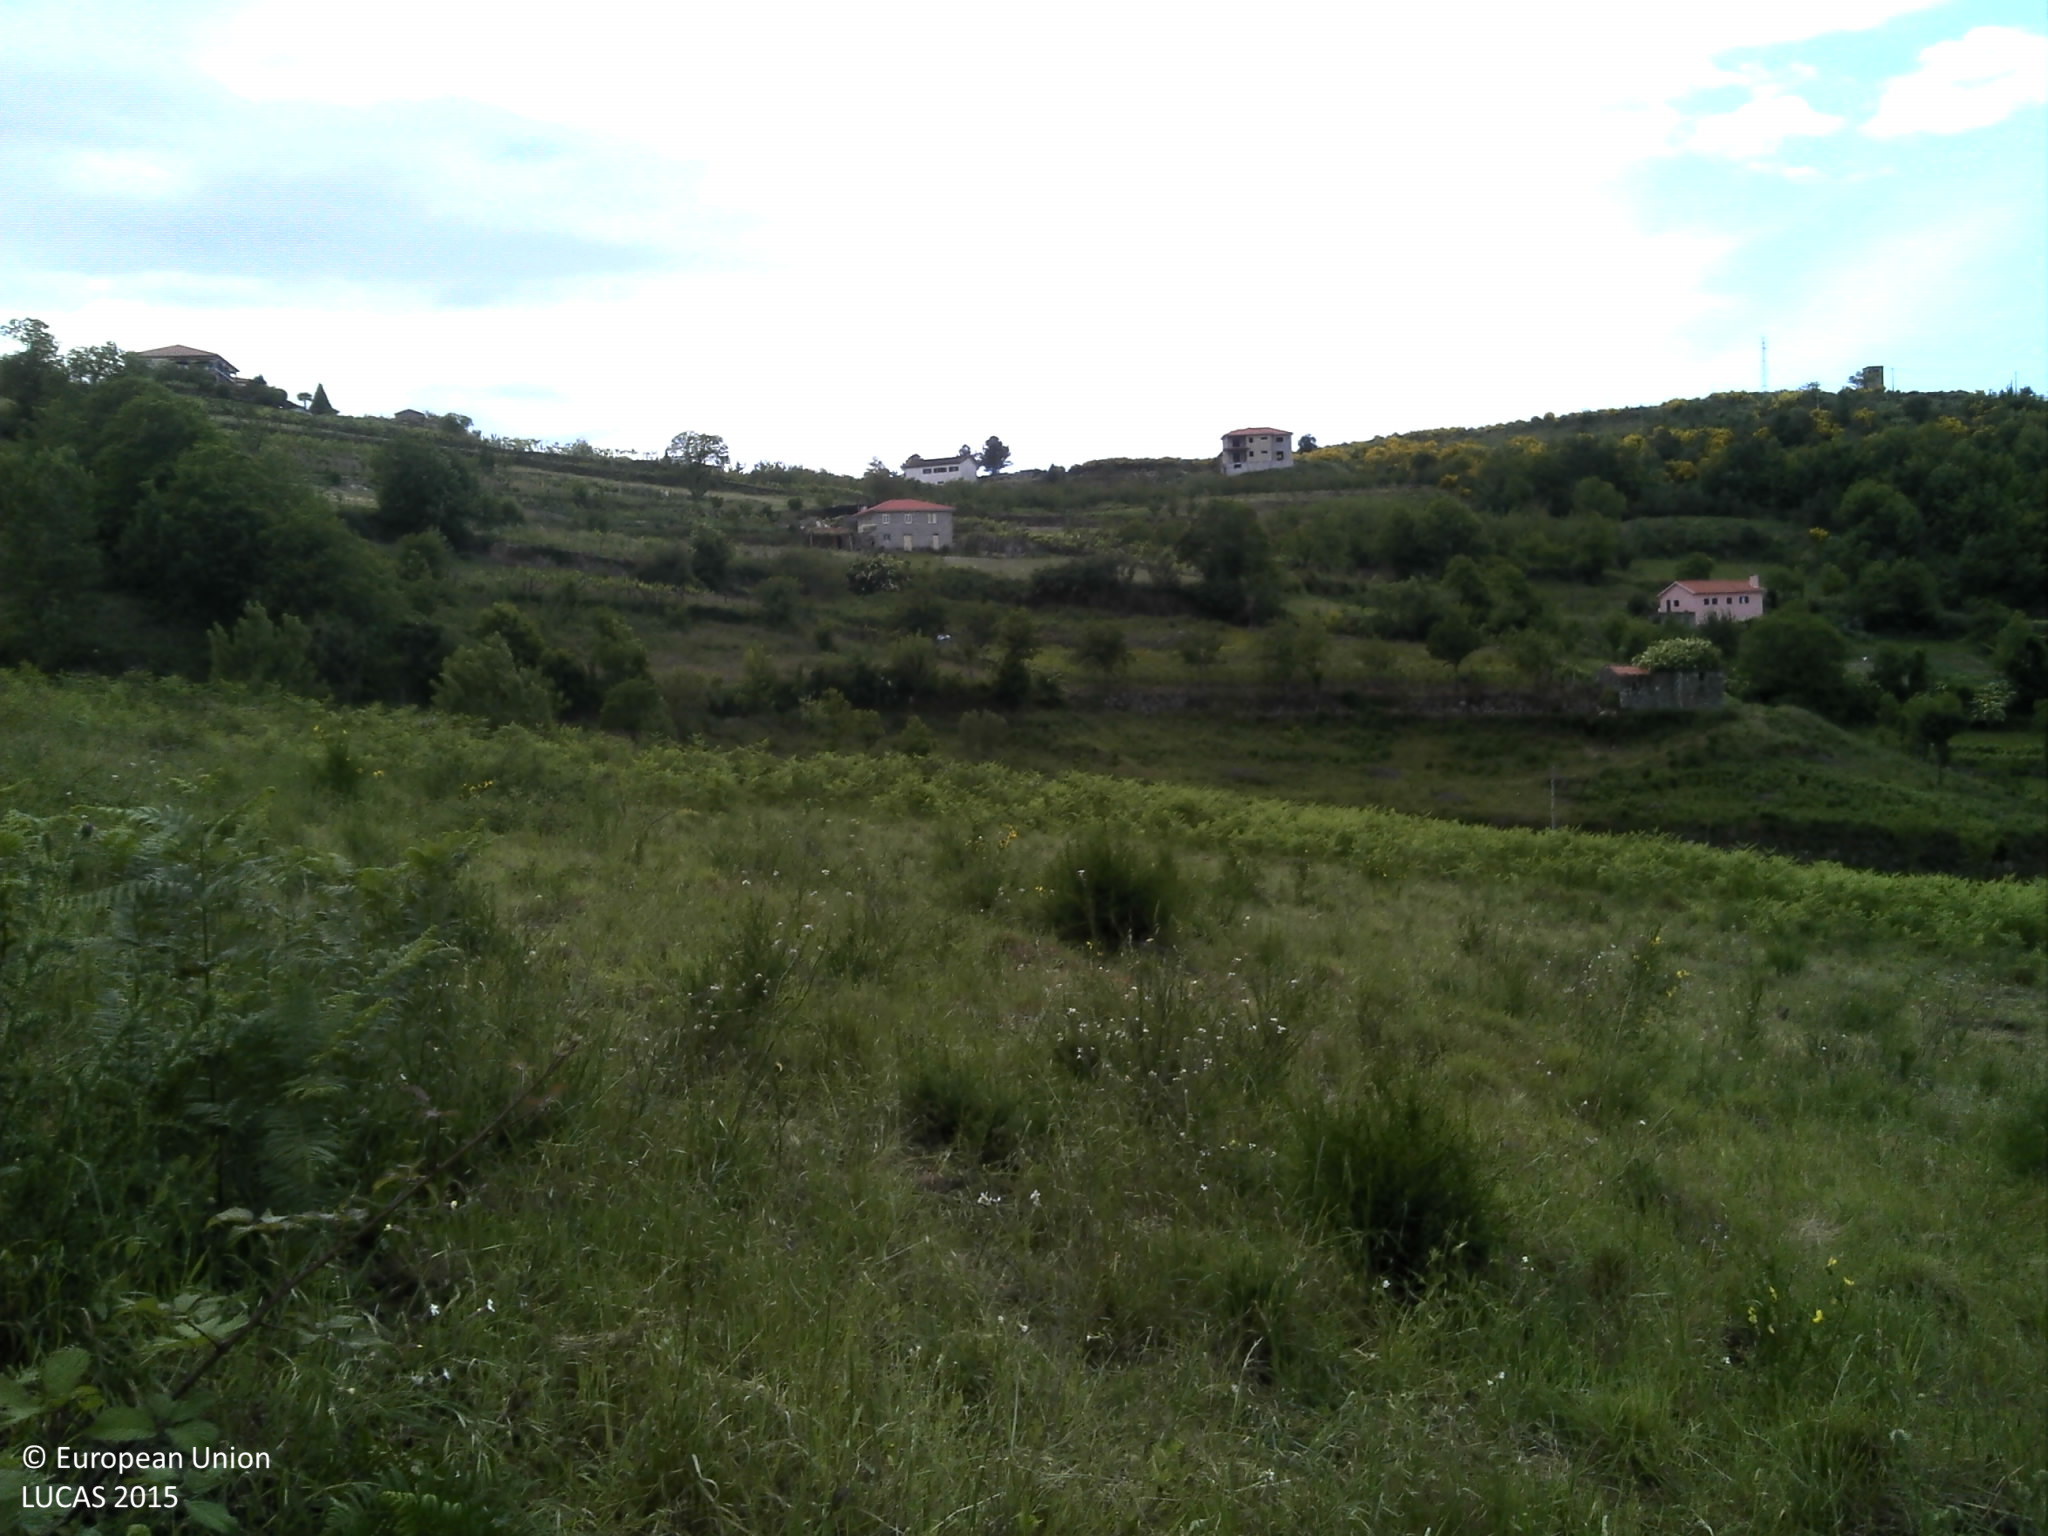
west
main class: Shrubland
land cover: Shrubland without tree cover
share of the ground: > 75 %
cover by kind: shrubs 90 %, herbaceous plants 5 %, unconsolidated bare surface 5 %
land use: Abandoned areas
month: May
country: PT
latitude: 41.0937
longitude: -7.9308
